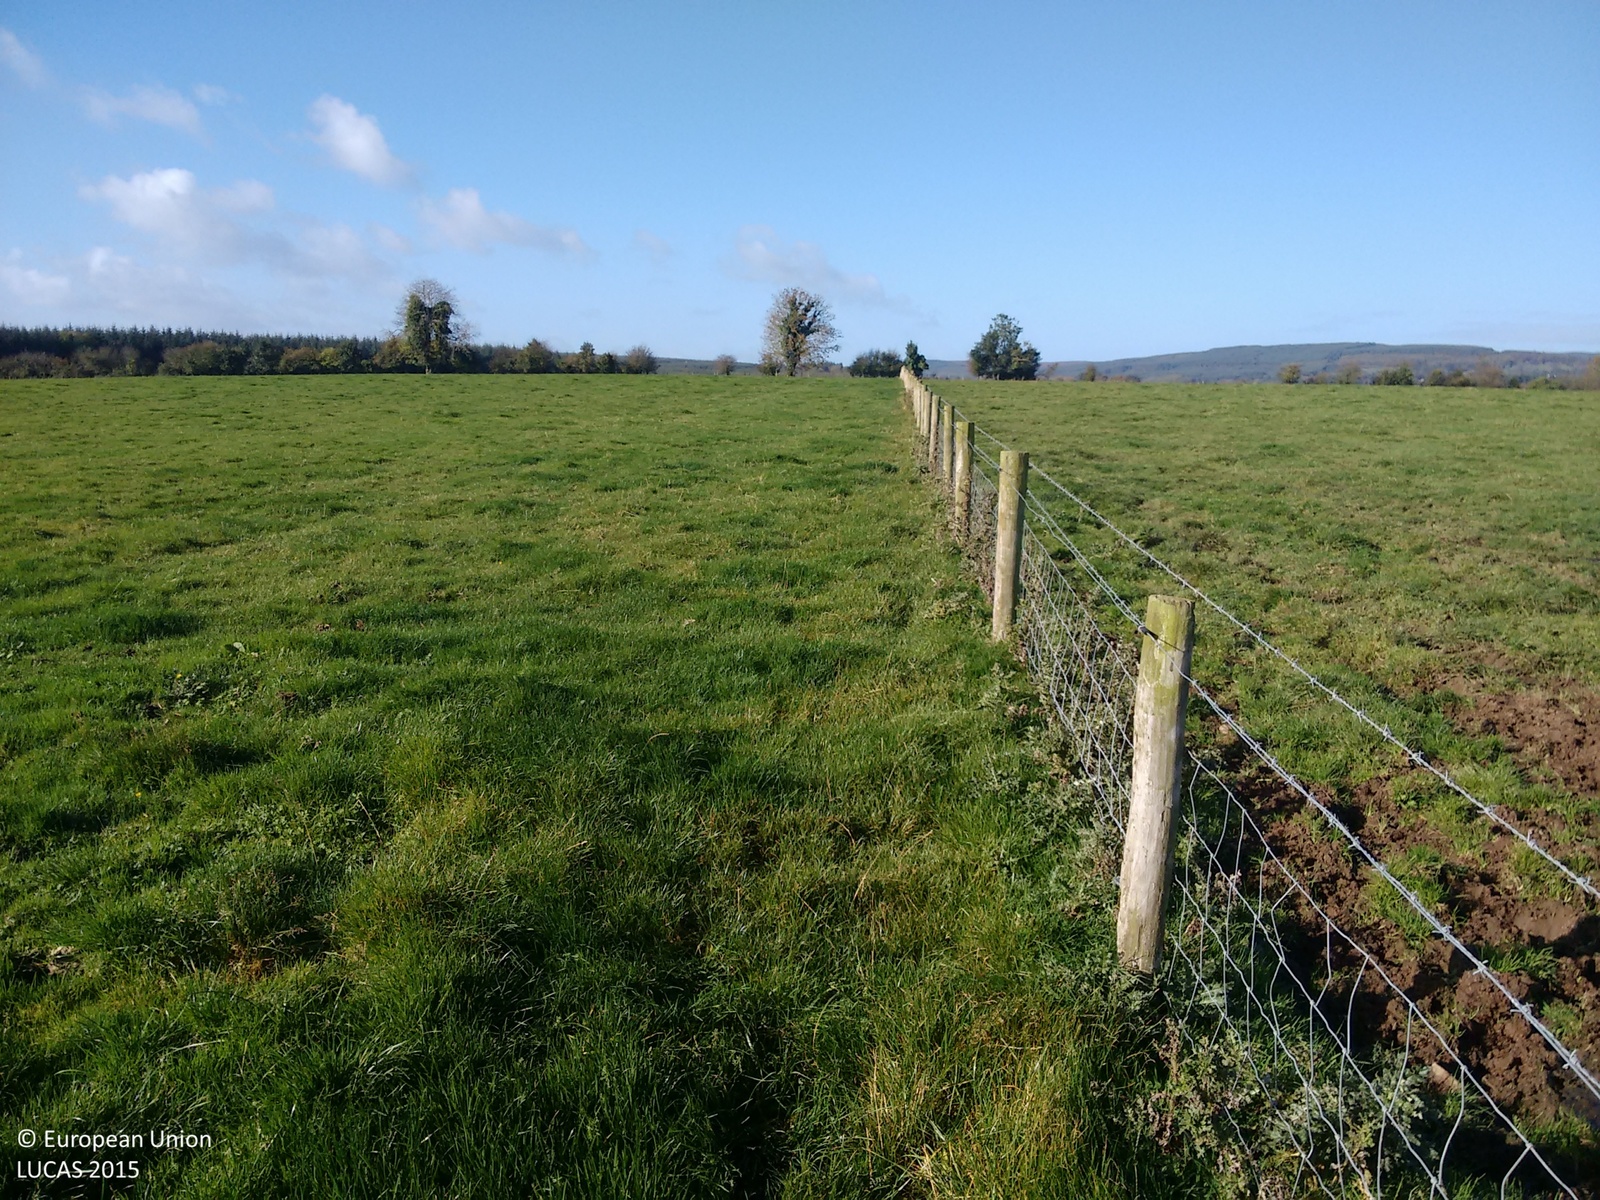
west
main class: Grassland
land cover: Grassland without tree/shrub cover
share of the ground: > 75 %
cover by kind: herbaceous plants 100 %
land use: Agriculture (excluding fallow land and kitchen gardens)
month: October
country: IE
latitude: 52.9992
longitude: -7.6106
